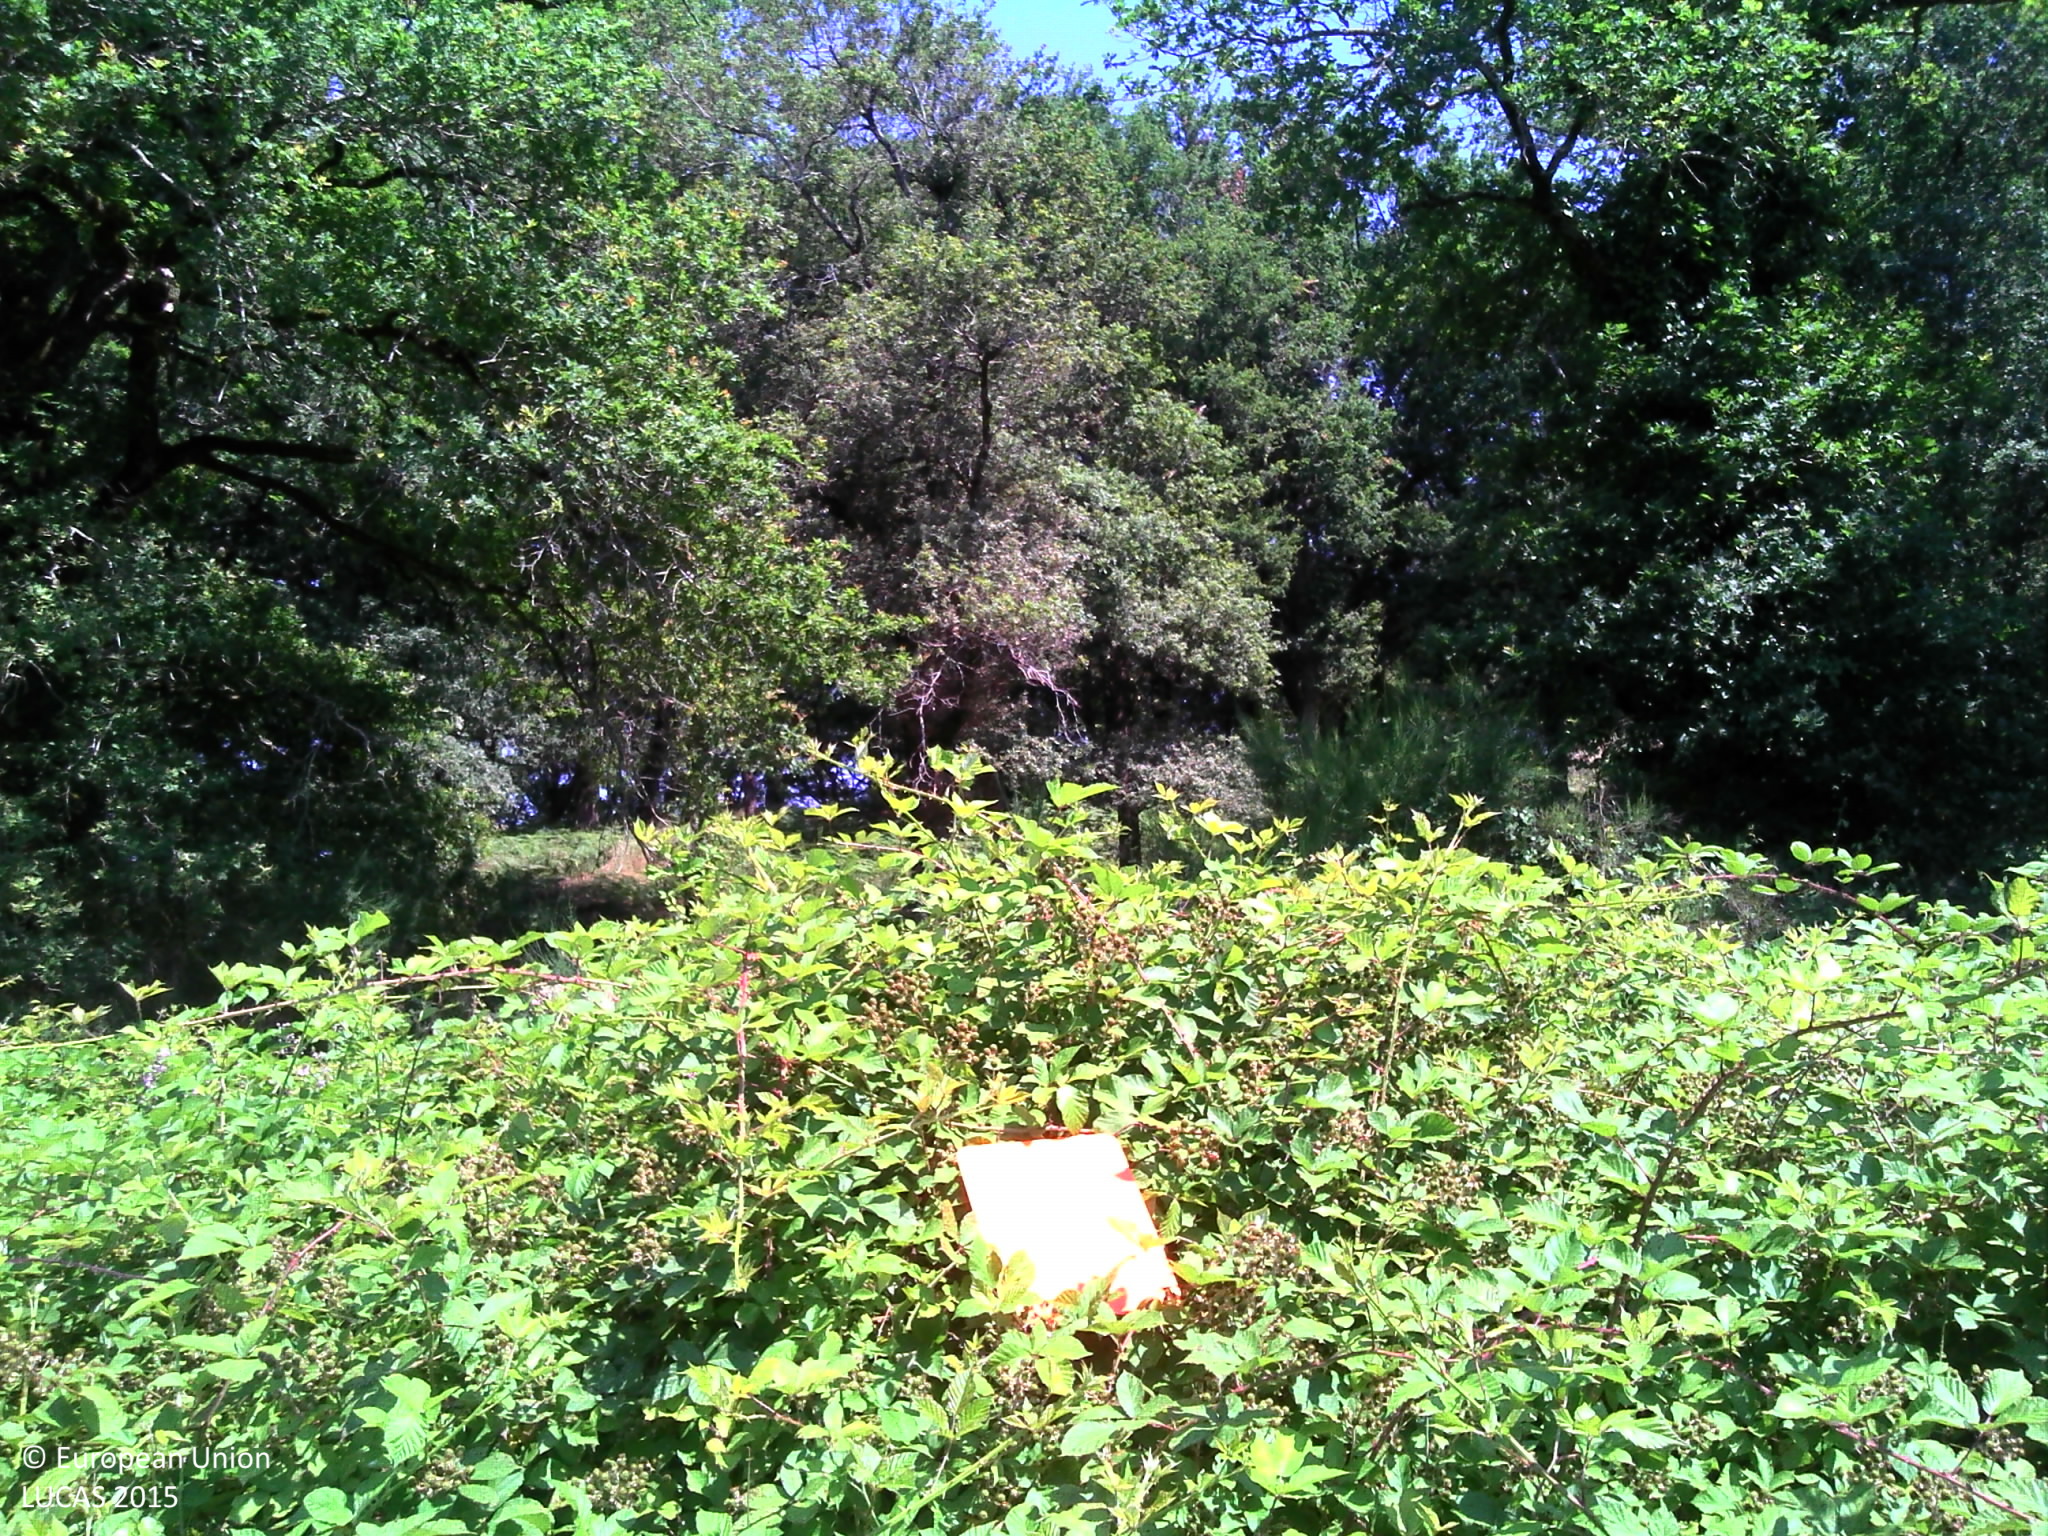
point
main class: Shrubland
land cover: Shrubland without tree cover
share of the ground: > 75 %
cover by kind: shrubs 55 %, herbaceous plants 45 %
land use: Abandoned areas
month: June
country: FR
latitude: 43.6465
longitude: -0.5610
